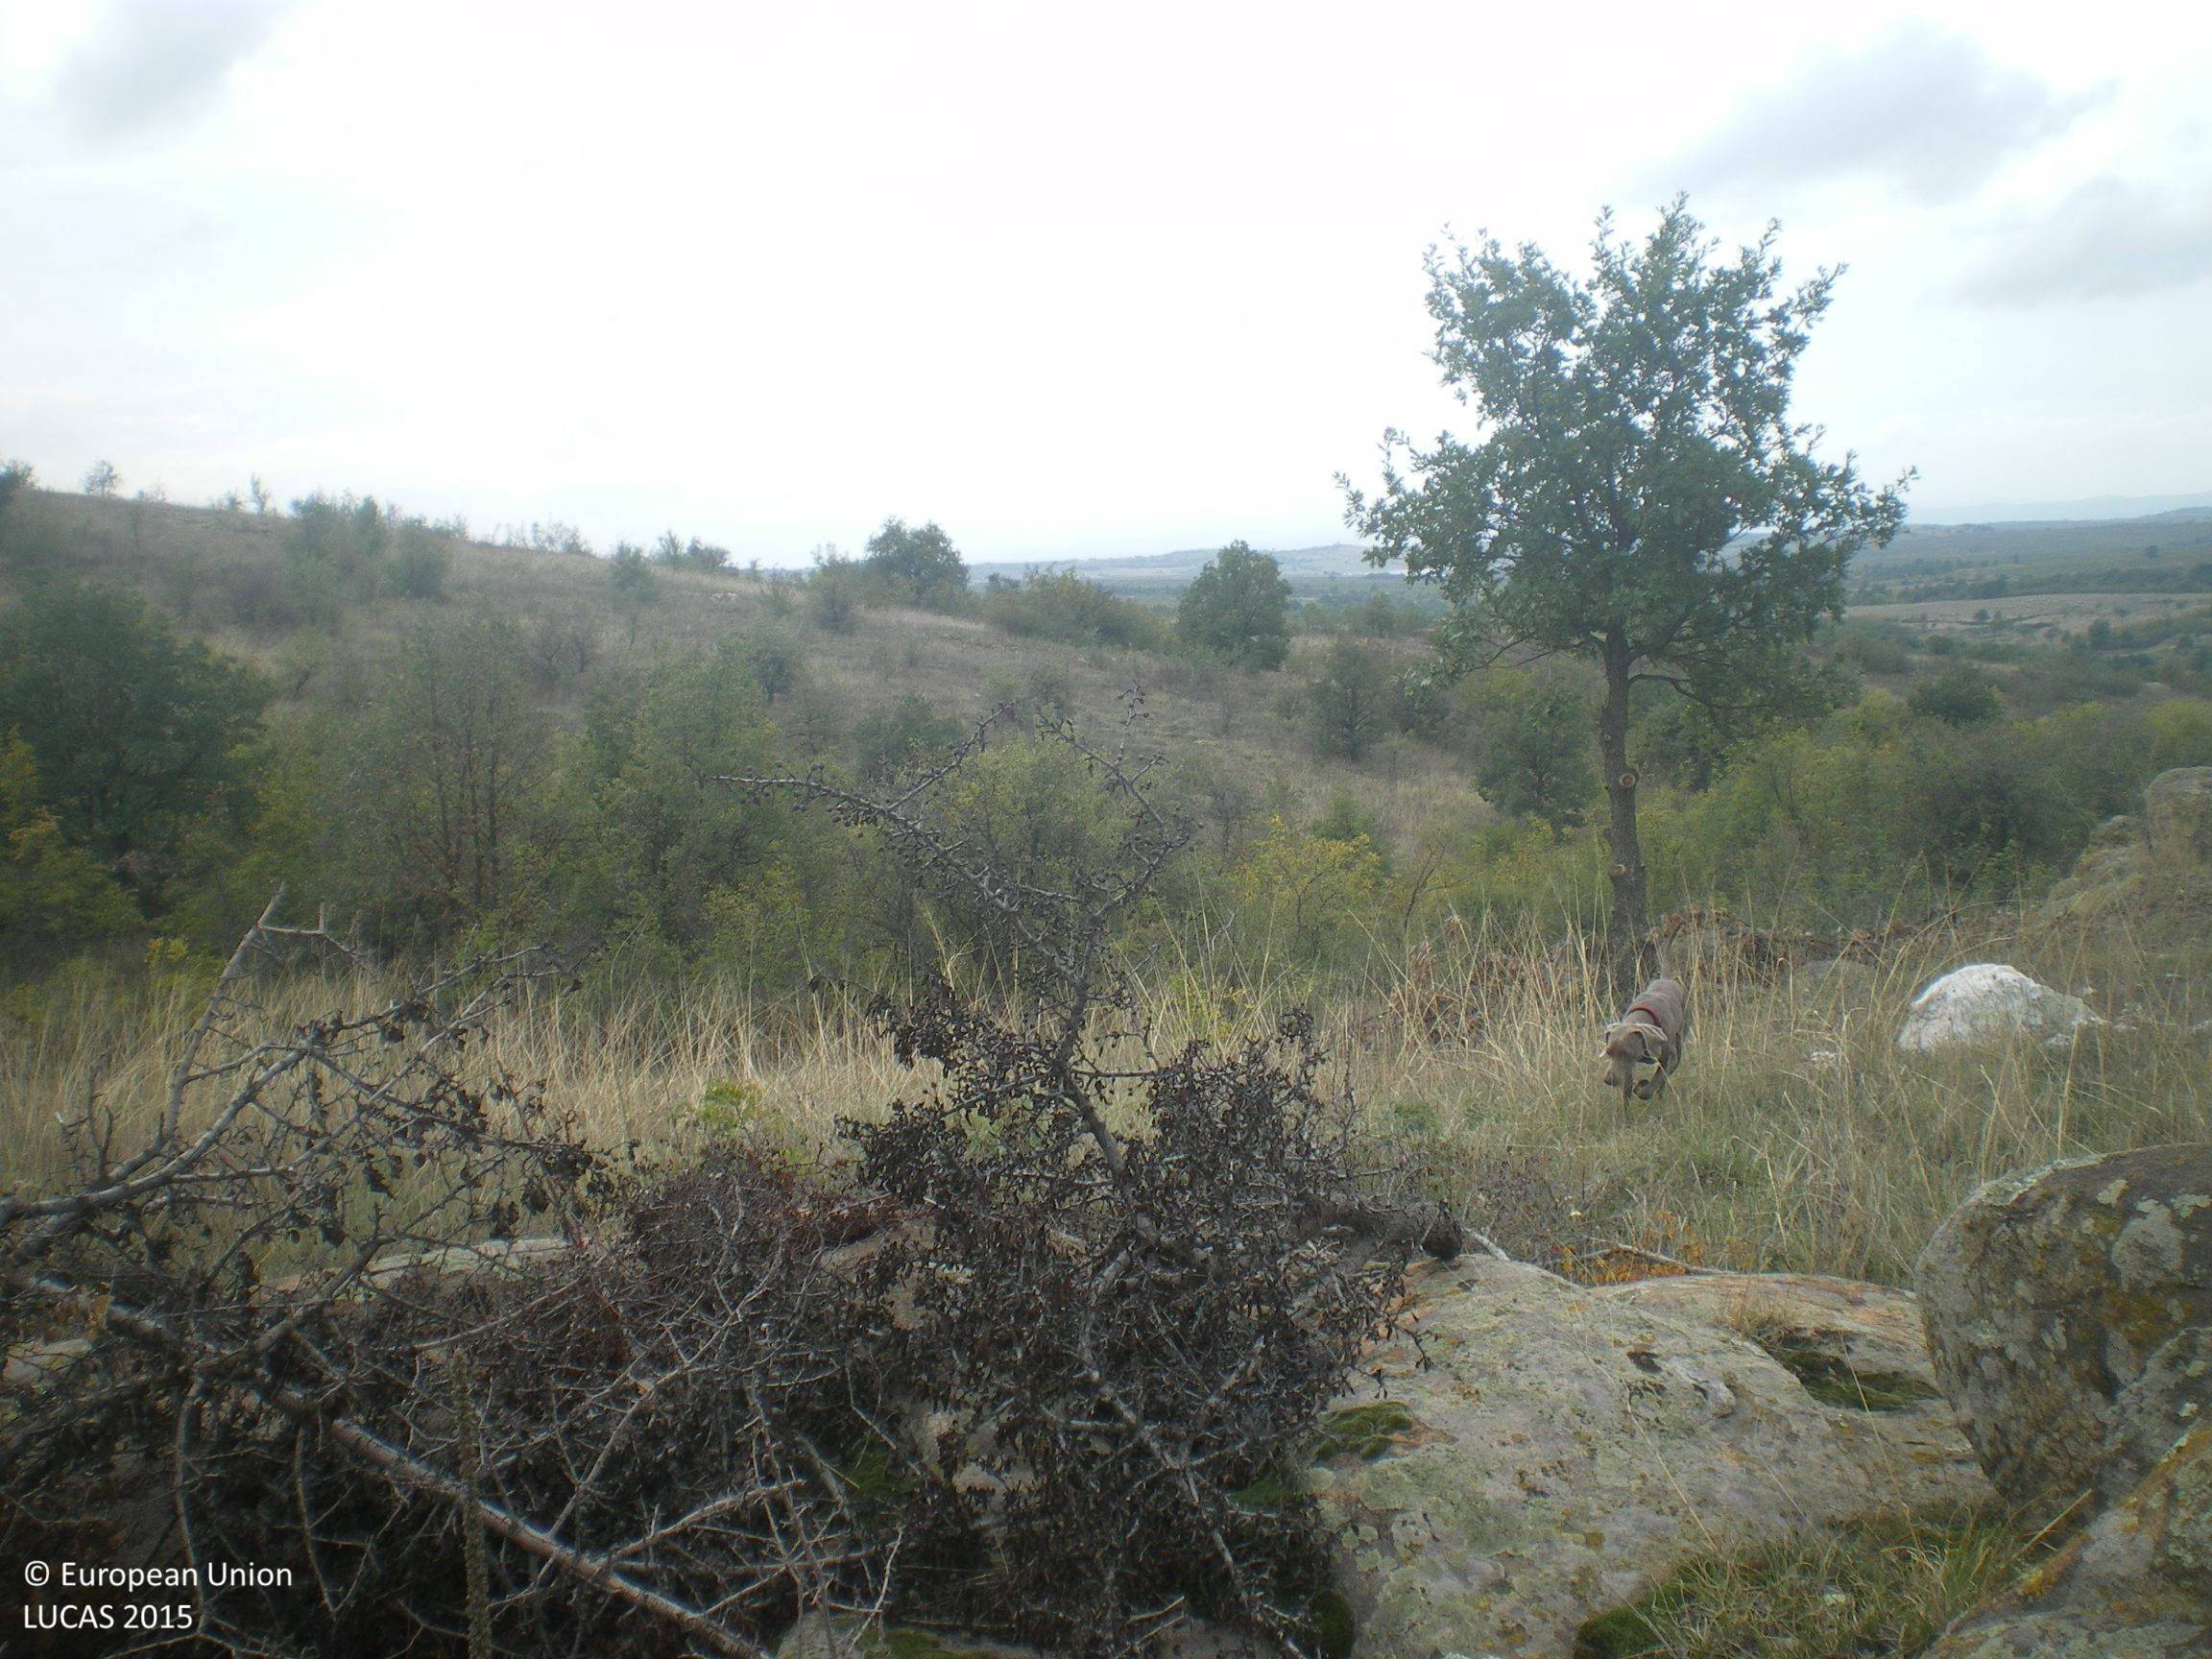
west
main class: Grassland
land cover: Grassland with sparse tree/shrub cover
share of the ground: > 75 %
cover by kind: herbaceous plants 85 %, shrubs 10 %, broadleaved forest trees 5 %
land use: Agriculture (excluding fallow land and kitchen gardens)
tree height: > 5 m
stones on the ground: < 10 %
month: October
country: BG
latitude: 41.9723
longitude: 26.0404
